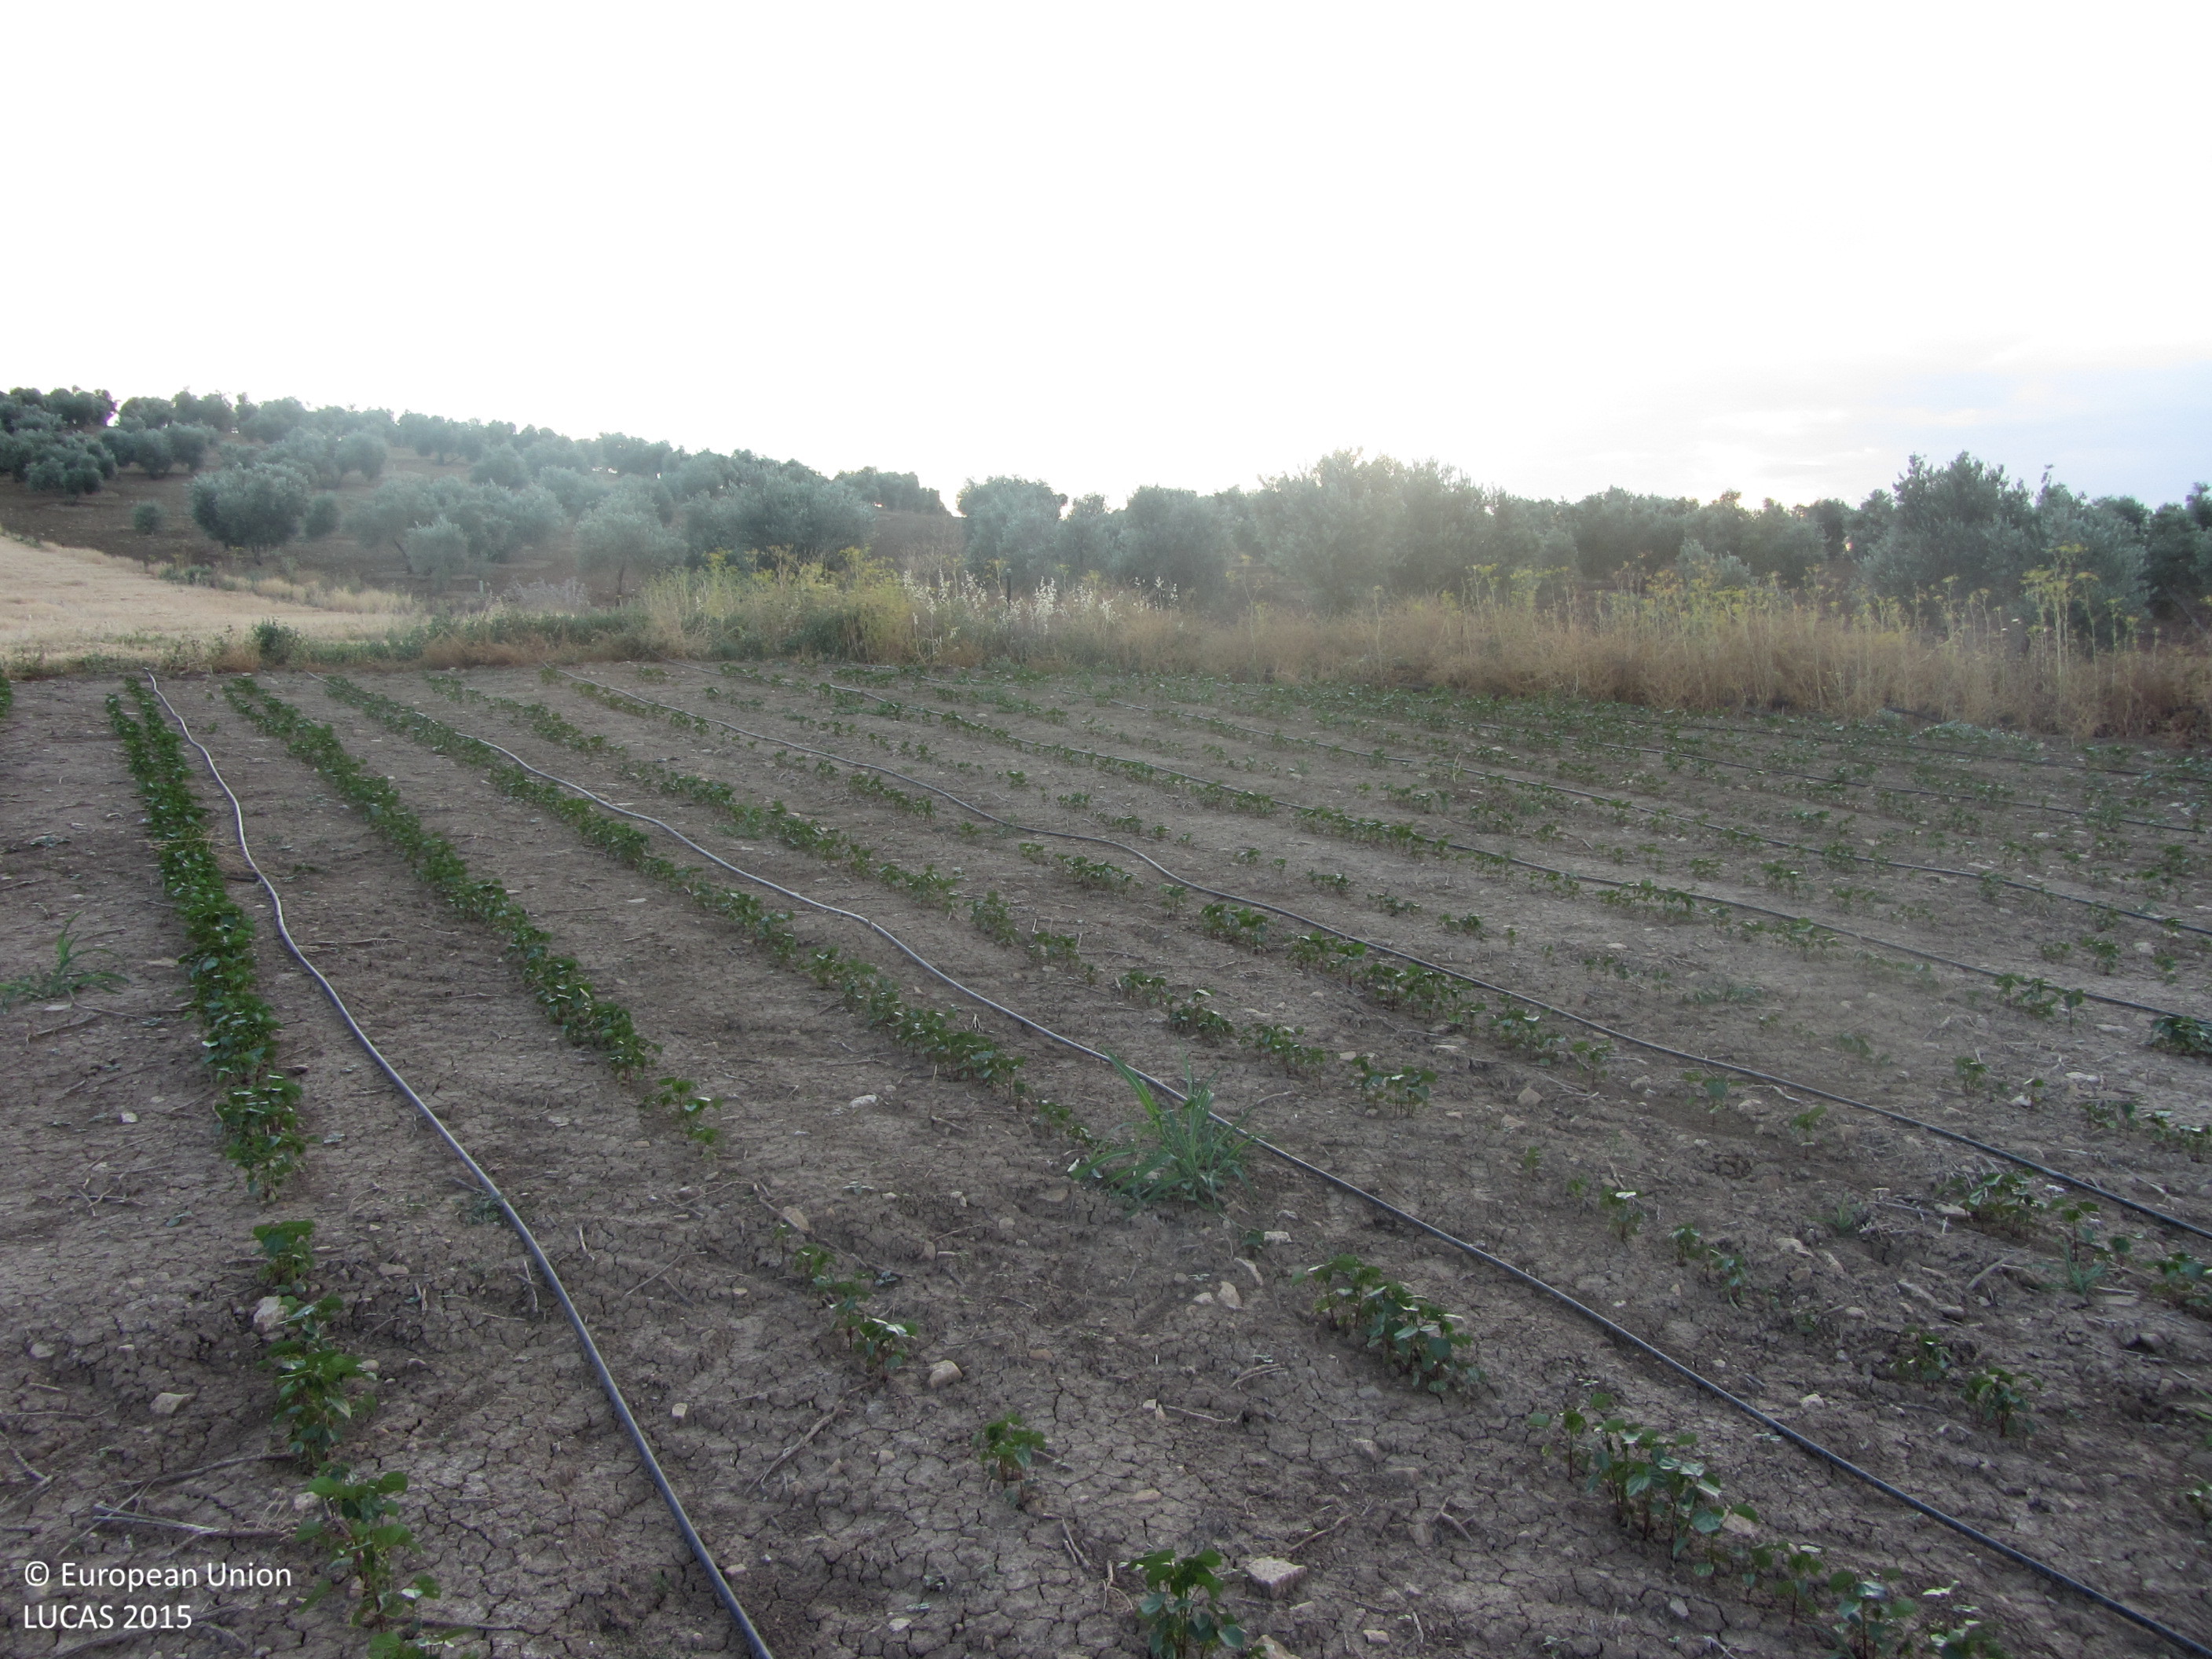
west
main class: Cropland
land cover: Cotton
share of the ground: < 10 %
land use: Agriculture (excluding fallow land and kitchen gardens)
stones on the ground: < 10 %
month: June
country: ES
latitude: 37.9292
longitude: -3.8036
